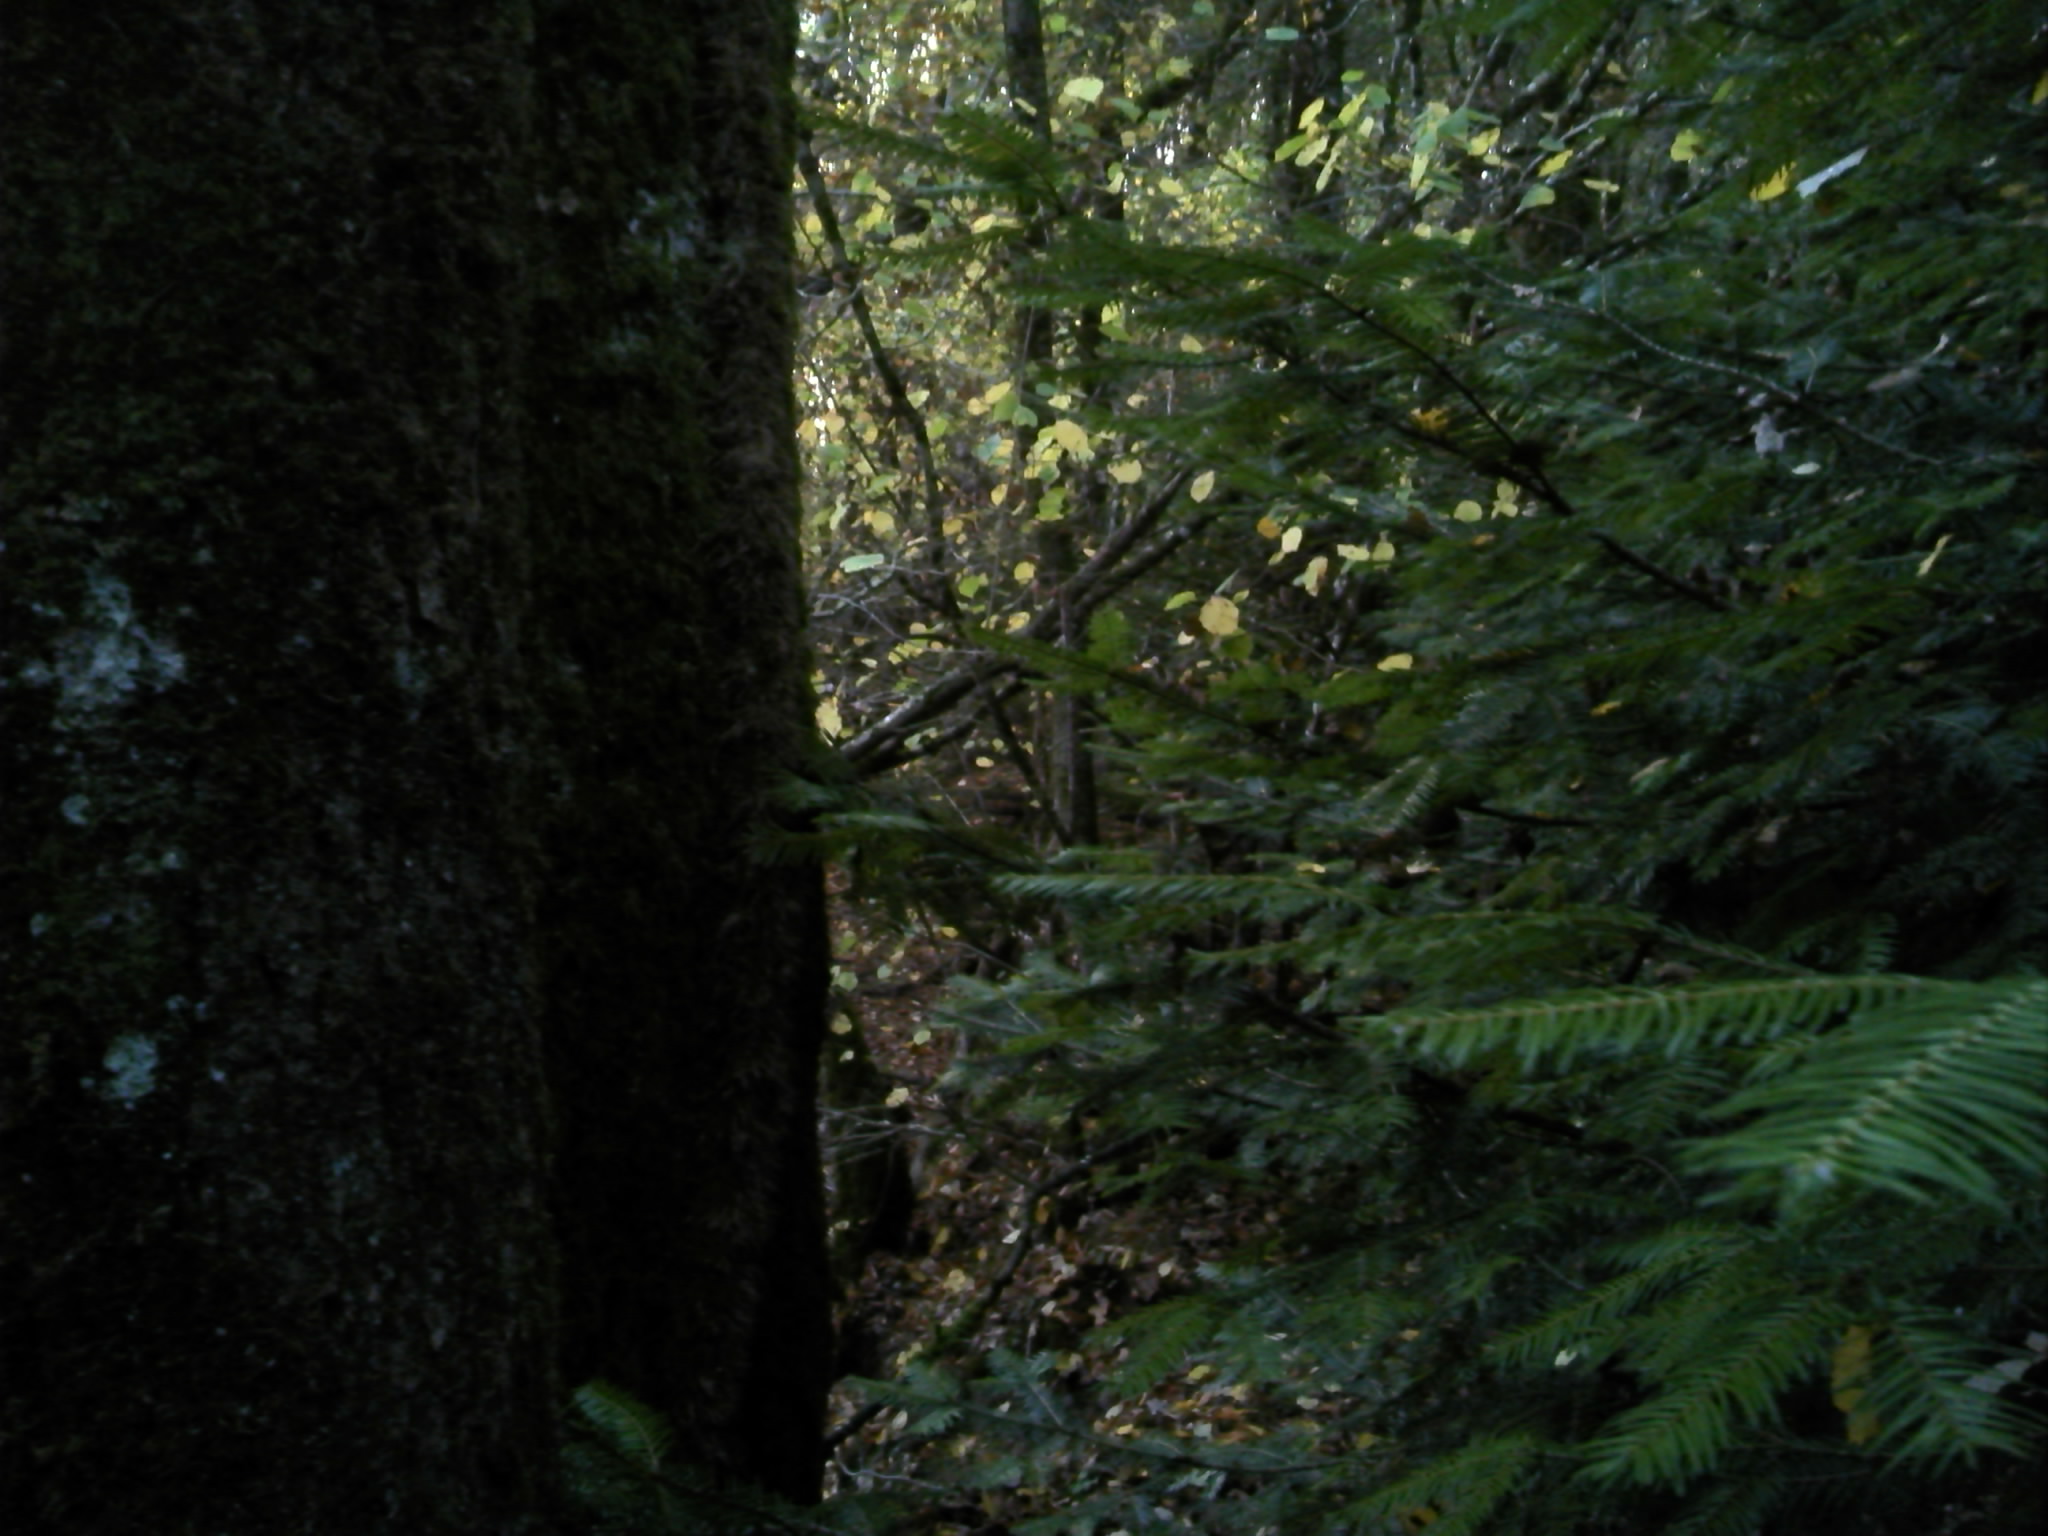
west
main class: Woodland
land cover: Other mixed woodland
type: hemiboreal forest and nemoral coniferous forest and mixed broadleaved-coniferous forest
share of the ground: > 75 %
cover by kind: coniferous forest trees 50 %, broadleaved forest trees 50 %
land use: Forestry
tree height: > 5 m
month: November
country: FR
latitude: 47.7372
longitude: -1.0667
